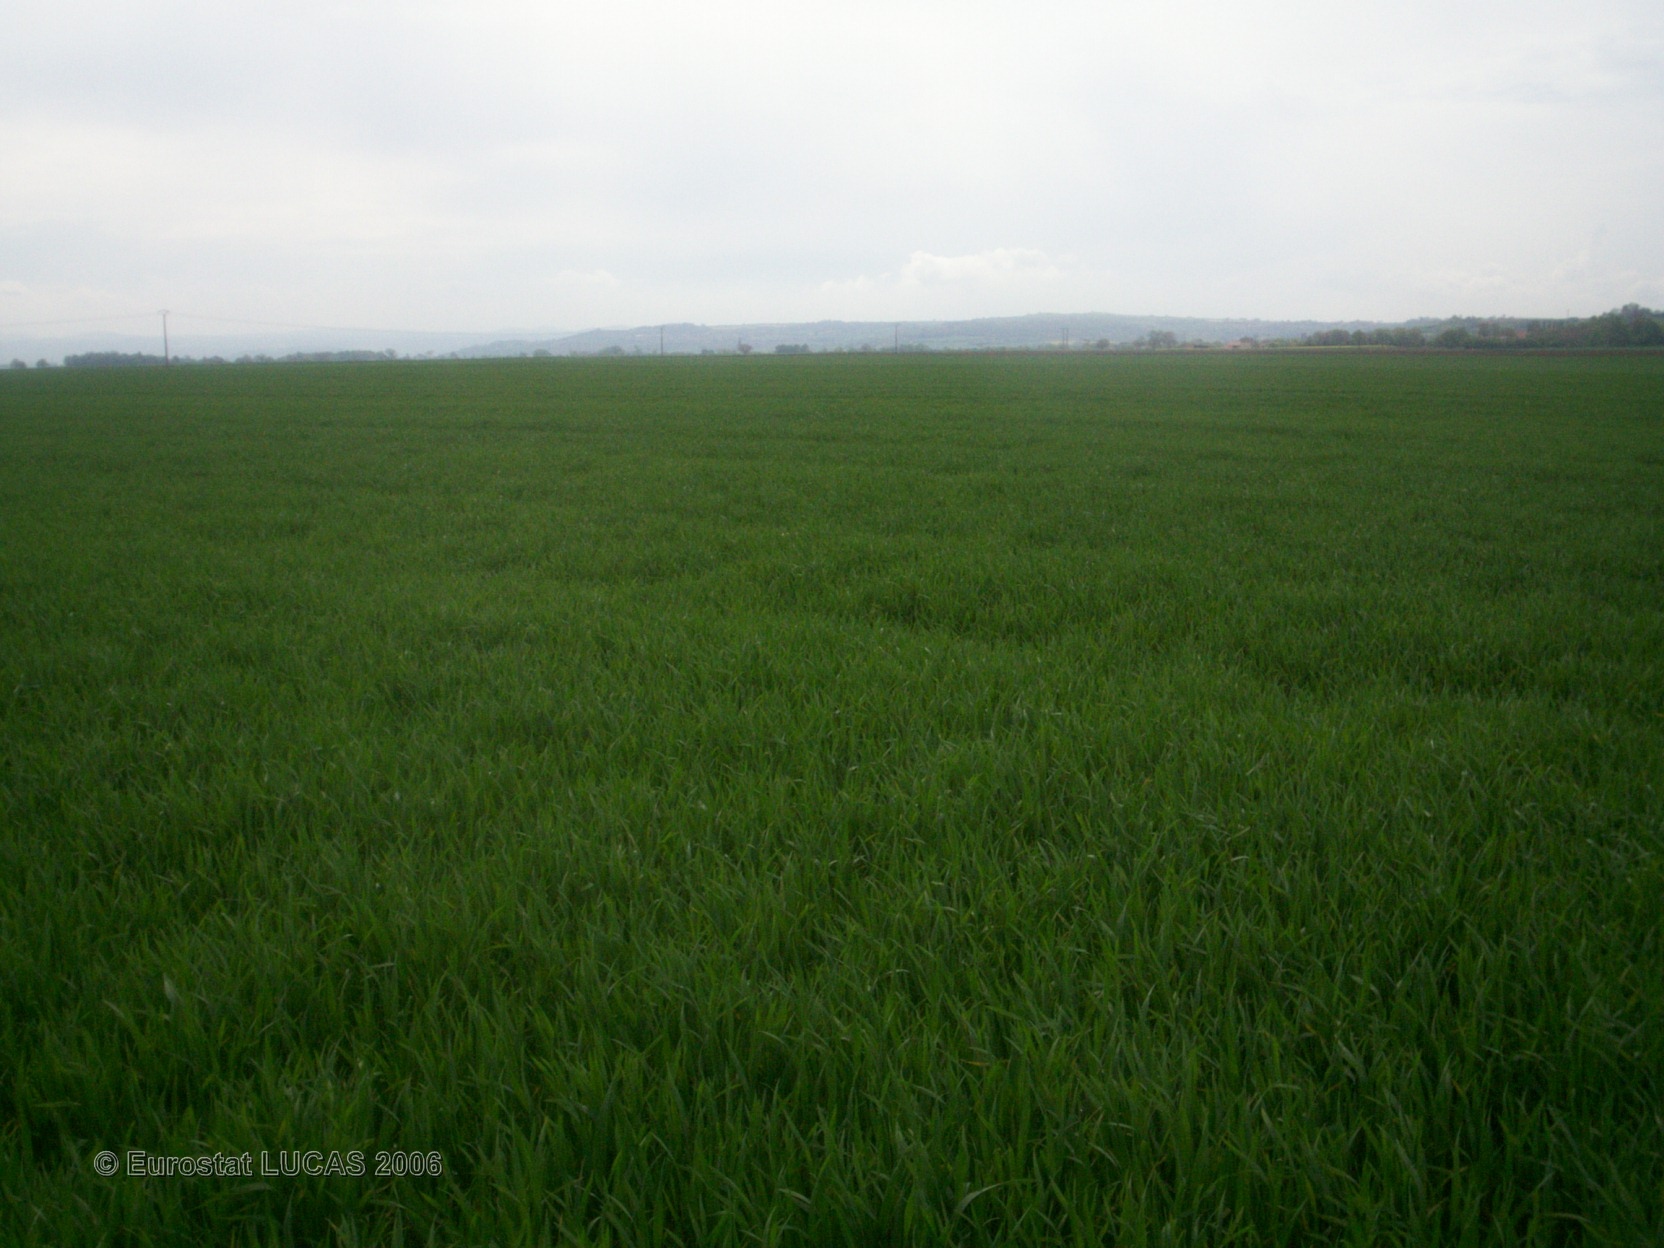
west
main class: Cropland
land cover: Common wheat
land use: Agriculture (excluding fallow land and kitchen gardens)
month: May
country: FR
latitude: 46.0290
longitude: 3.2427
